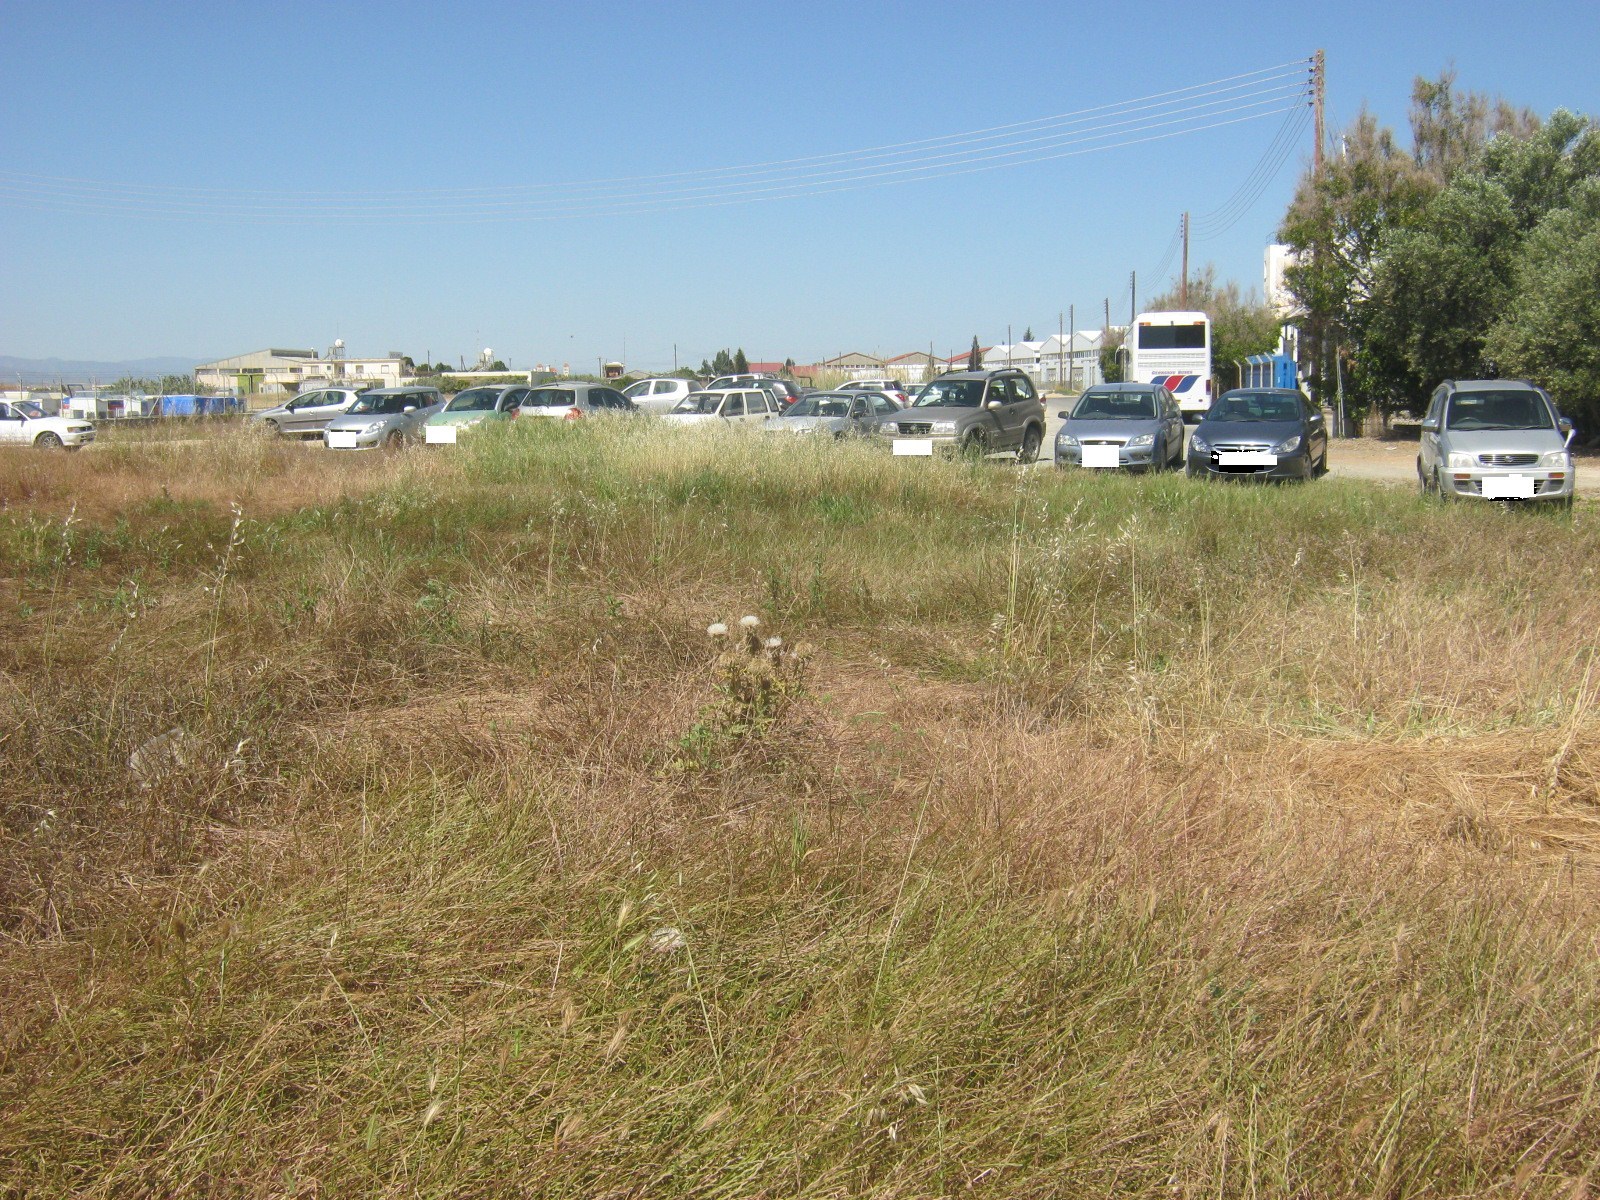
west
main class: Grassland
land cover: Grassland without tree/shrub cover
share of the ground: 50 - 75 %
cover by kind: herbaceous plants 65 %, unconsolidated bare surface 30 %, shrubs 5 %
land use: Semi-natural and natural areas not in use
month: May
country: CY
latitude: 35.1482
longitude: 33.2277
